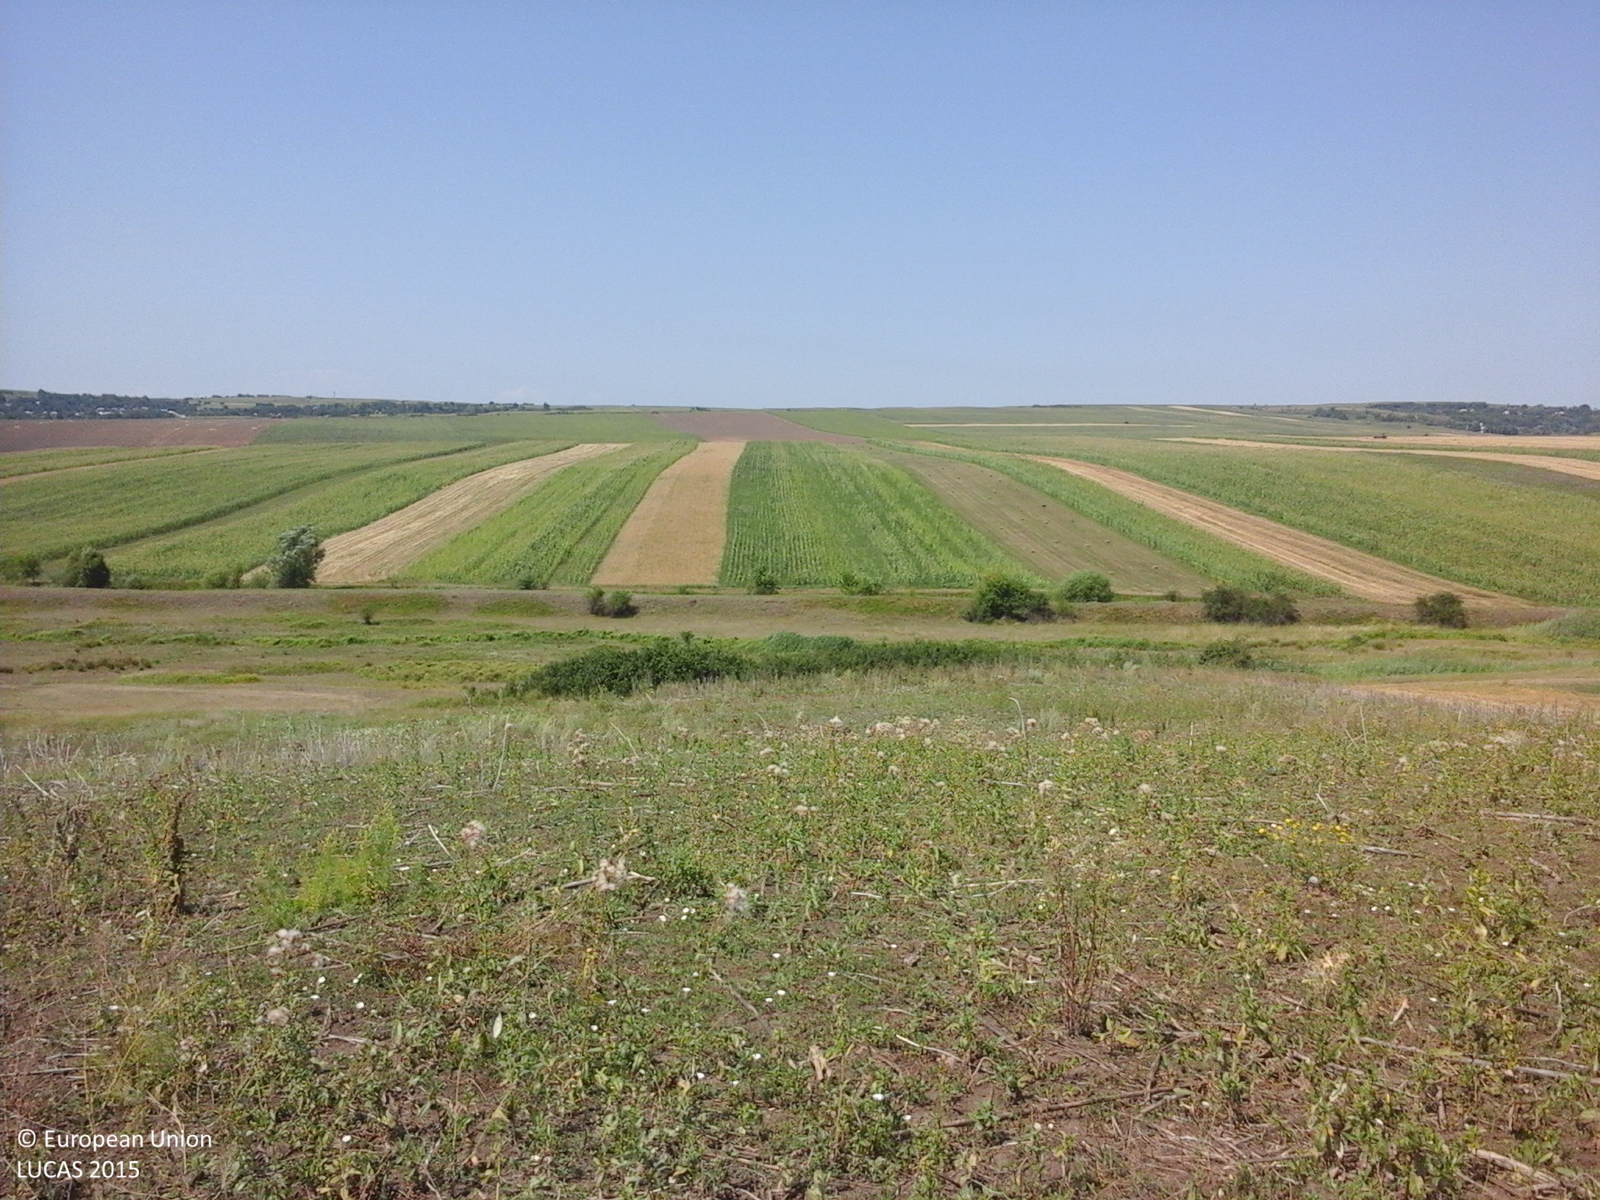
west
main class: Grassland
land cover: Spontaneously vegetated surfaces
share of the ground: 25 - 50 %
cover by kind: herbaceous plants 100 %
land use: Fallow land
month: July
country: RO
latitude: 46.2278
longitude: 27.2282
